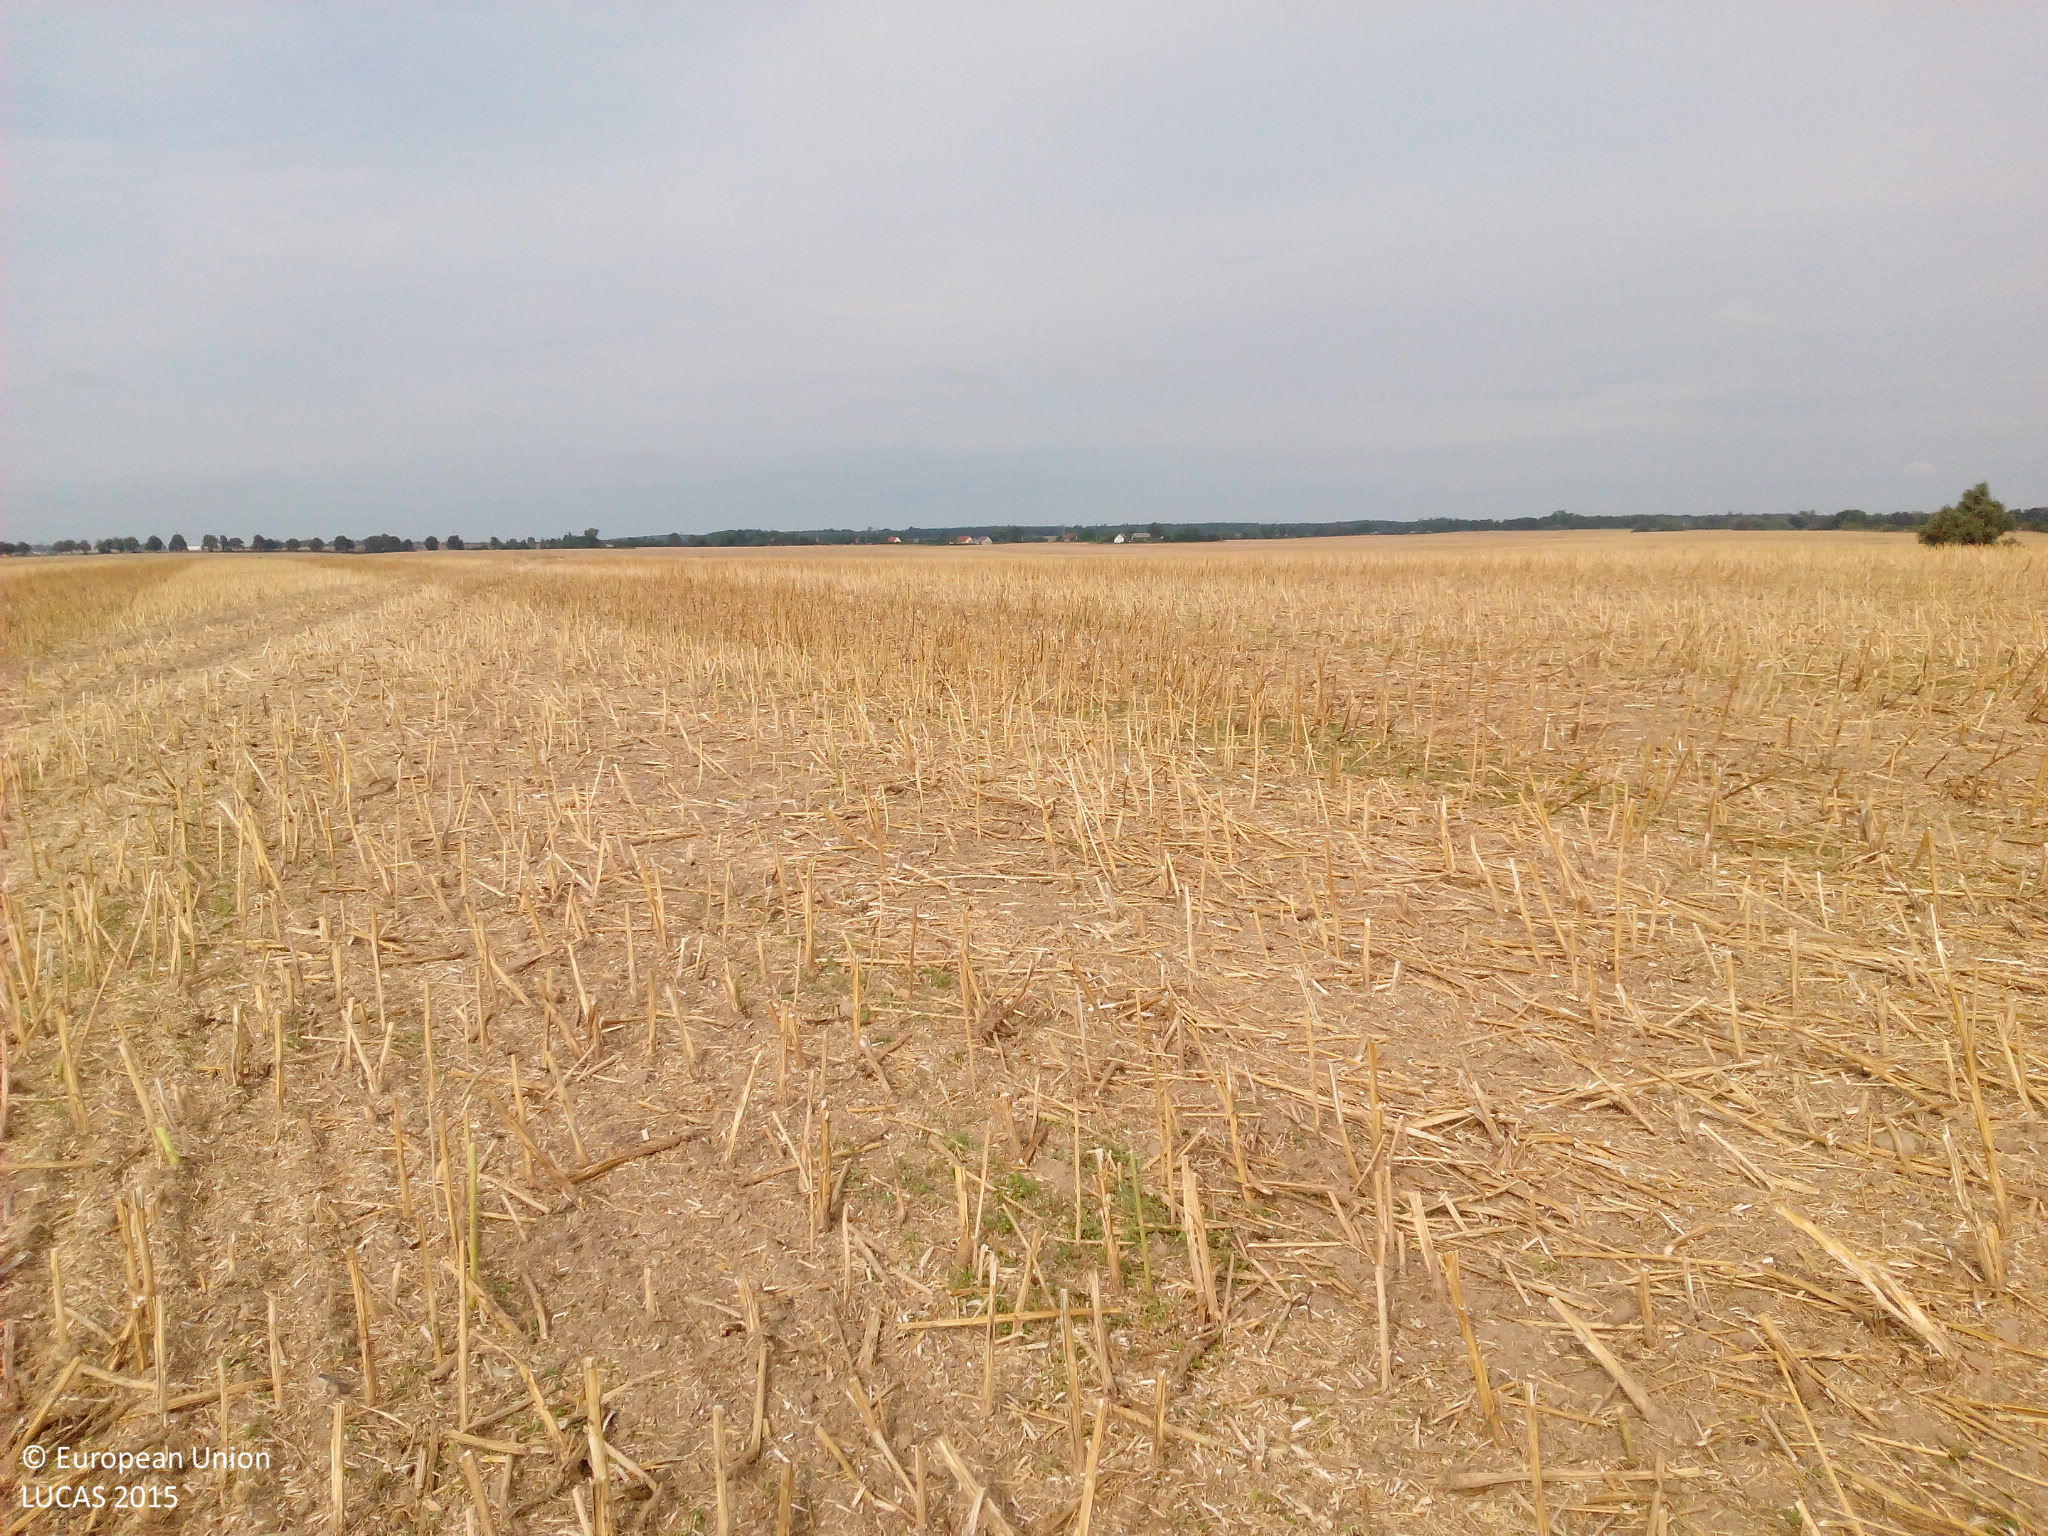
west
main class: Cropland
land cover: Rape and turnip rape
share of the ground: < 10 %
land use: Agriculture (excluding fallow land and kitchen gardens)
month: August
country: DE
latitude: 53.5931
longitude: 13.2177
